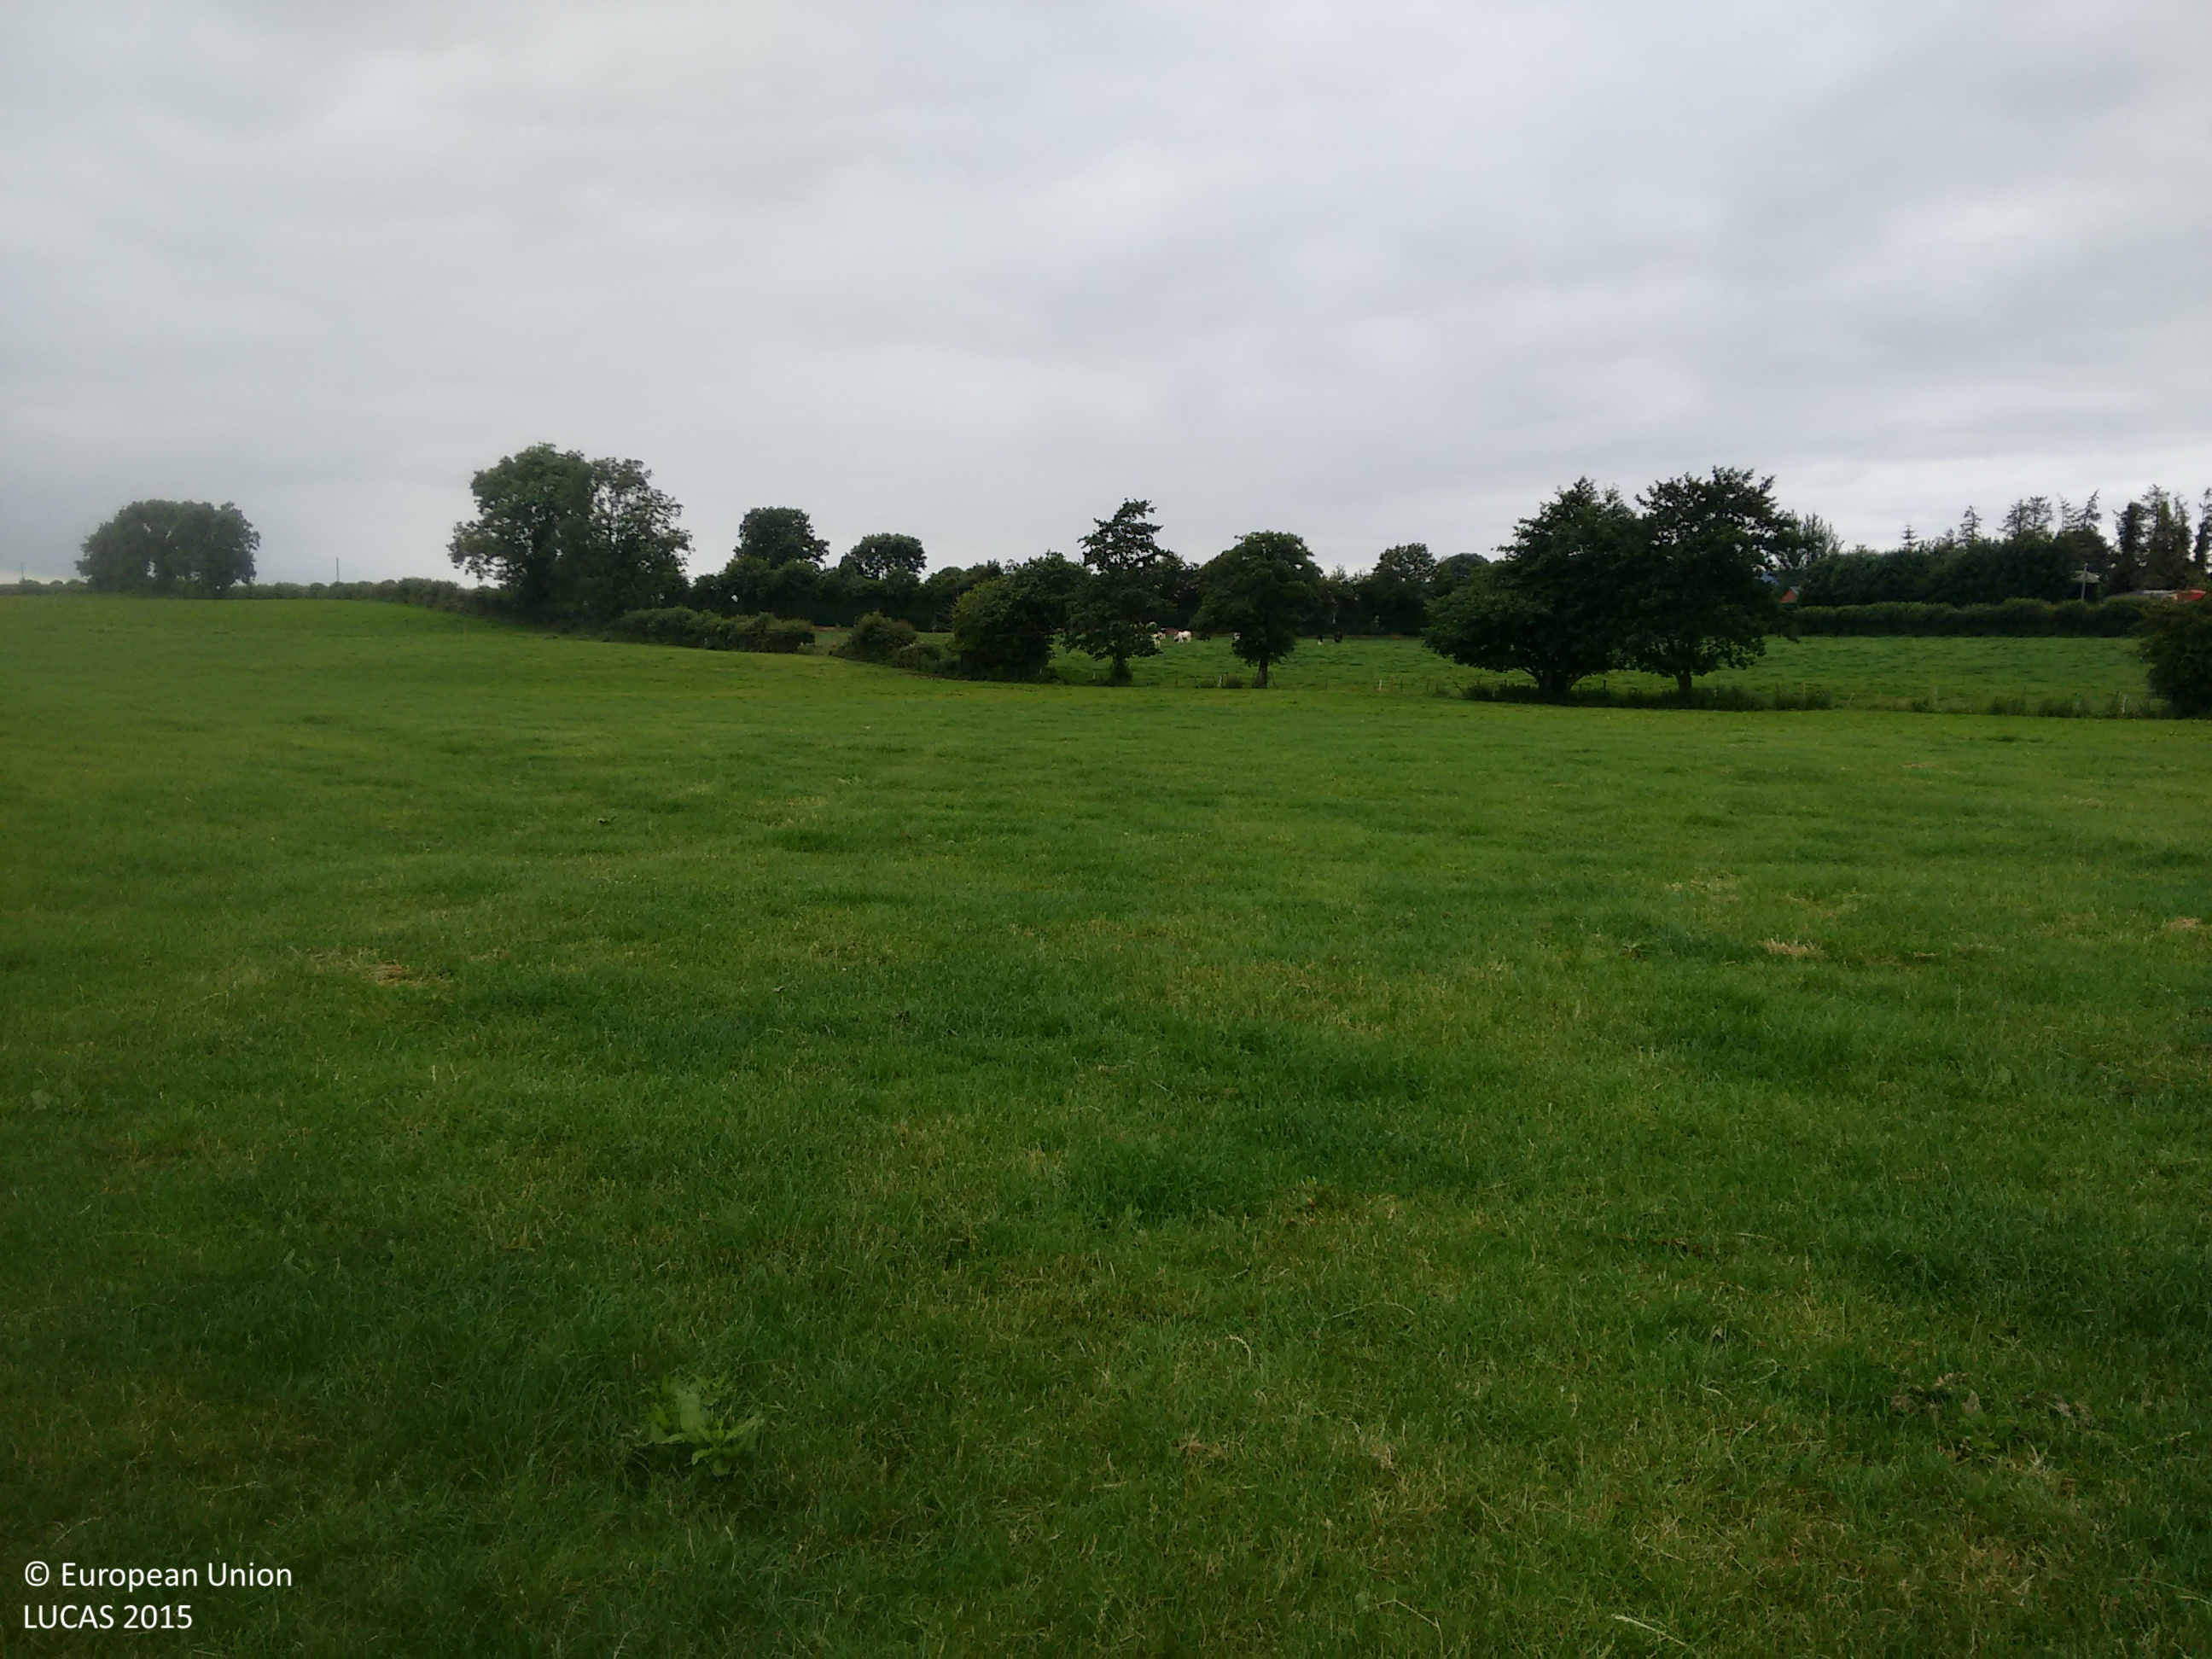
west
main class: Grassland
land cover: Grassland without tree/shrub cover
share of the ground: > 75 %
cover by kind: herbaceous plants 100 %
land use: Agriculture (excluding fallow land and kitchen gardens)
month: July
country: IE
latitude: 52.9260
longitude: -6.7197
